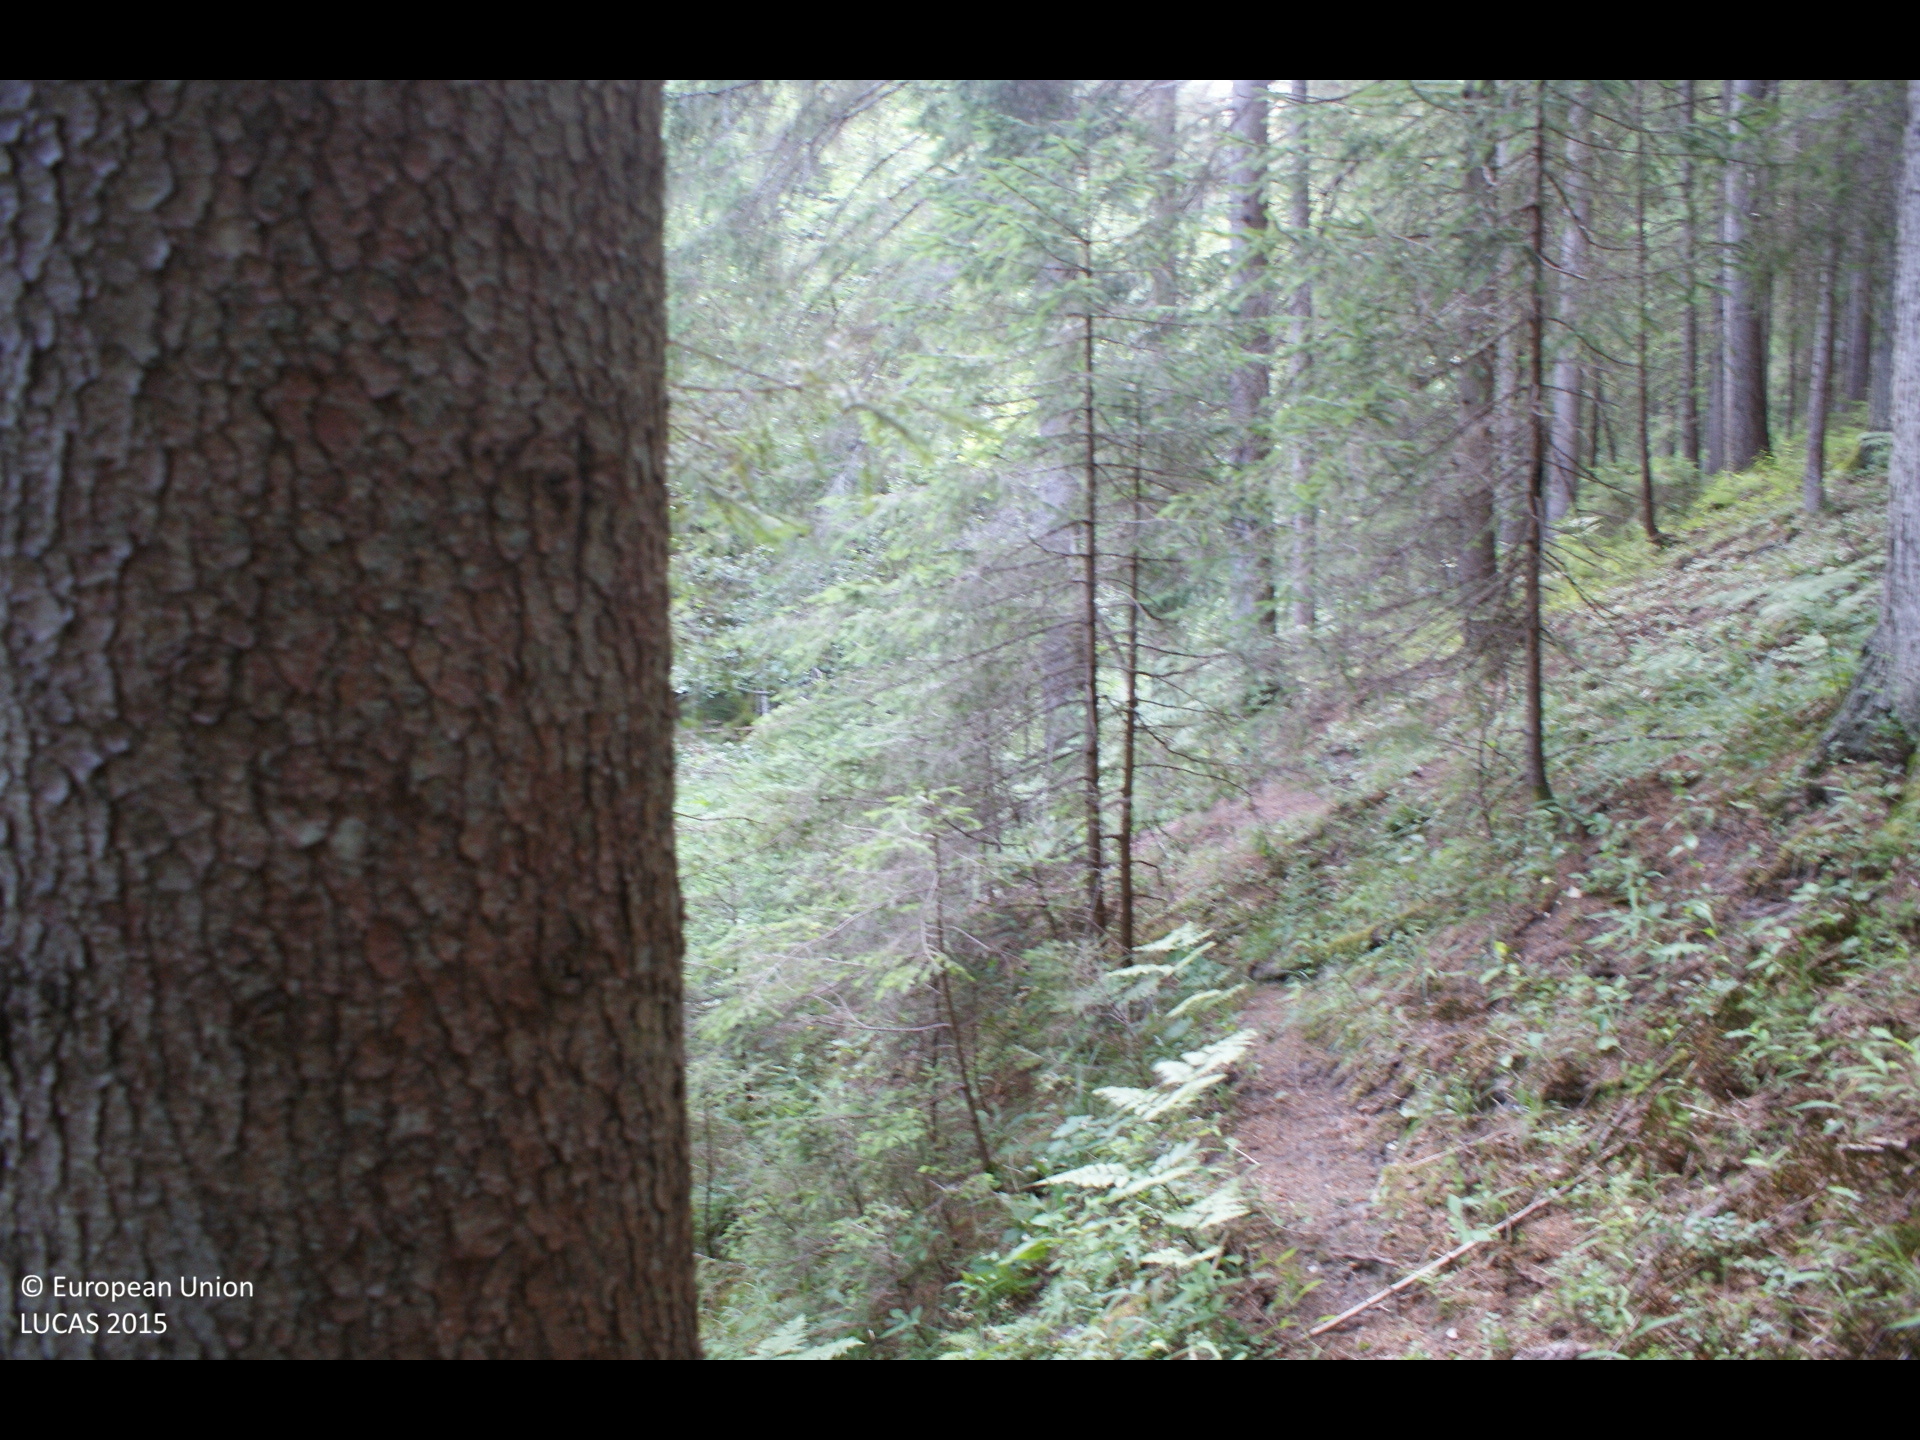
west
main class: Woodland
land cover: Spruce dominated coniferous woodland
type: alpine coniferous forest
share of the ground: > 75 %
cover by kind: coniferous forest trees 85 %, shrubs 5 %, herbaceous plants 5 %, lichens and mosses 5 %
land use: Forestry
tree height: > 5 m
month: July
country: AT
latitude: 47.7663
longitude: 15.4050
